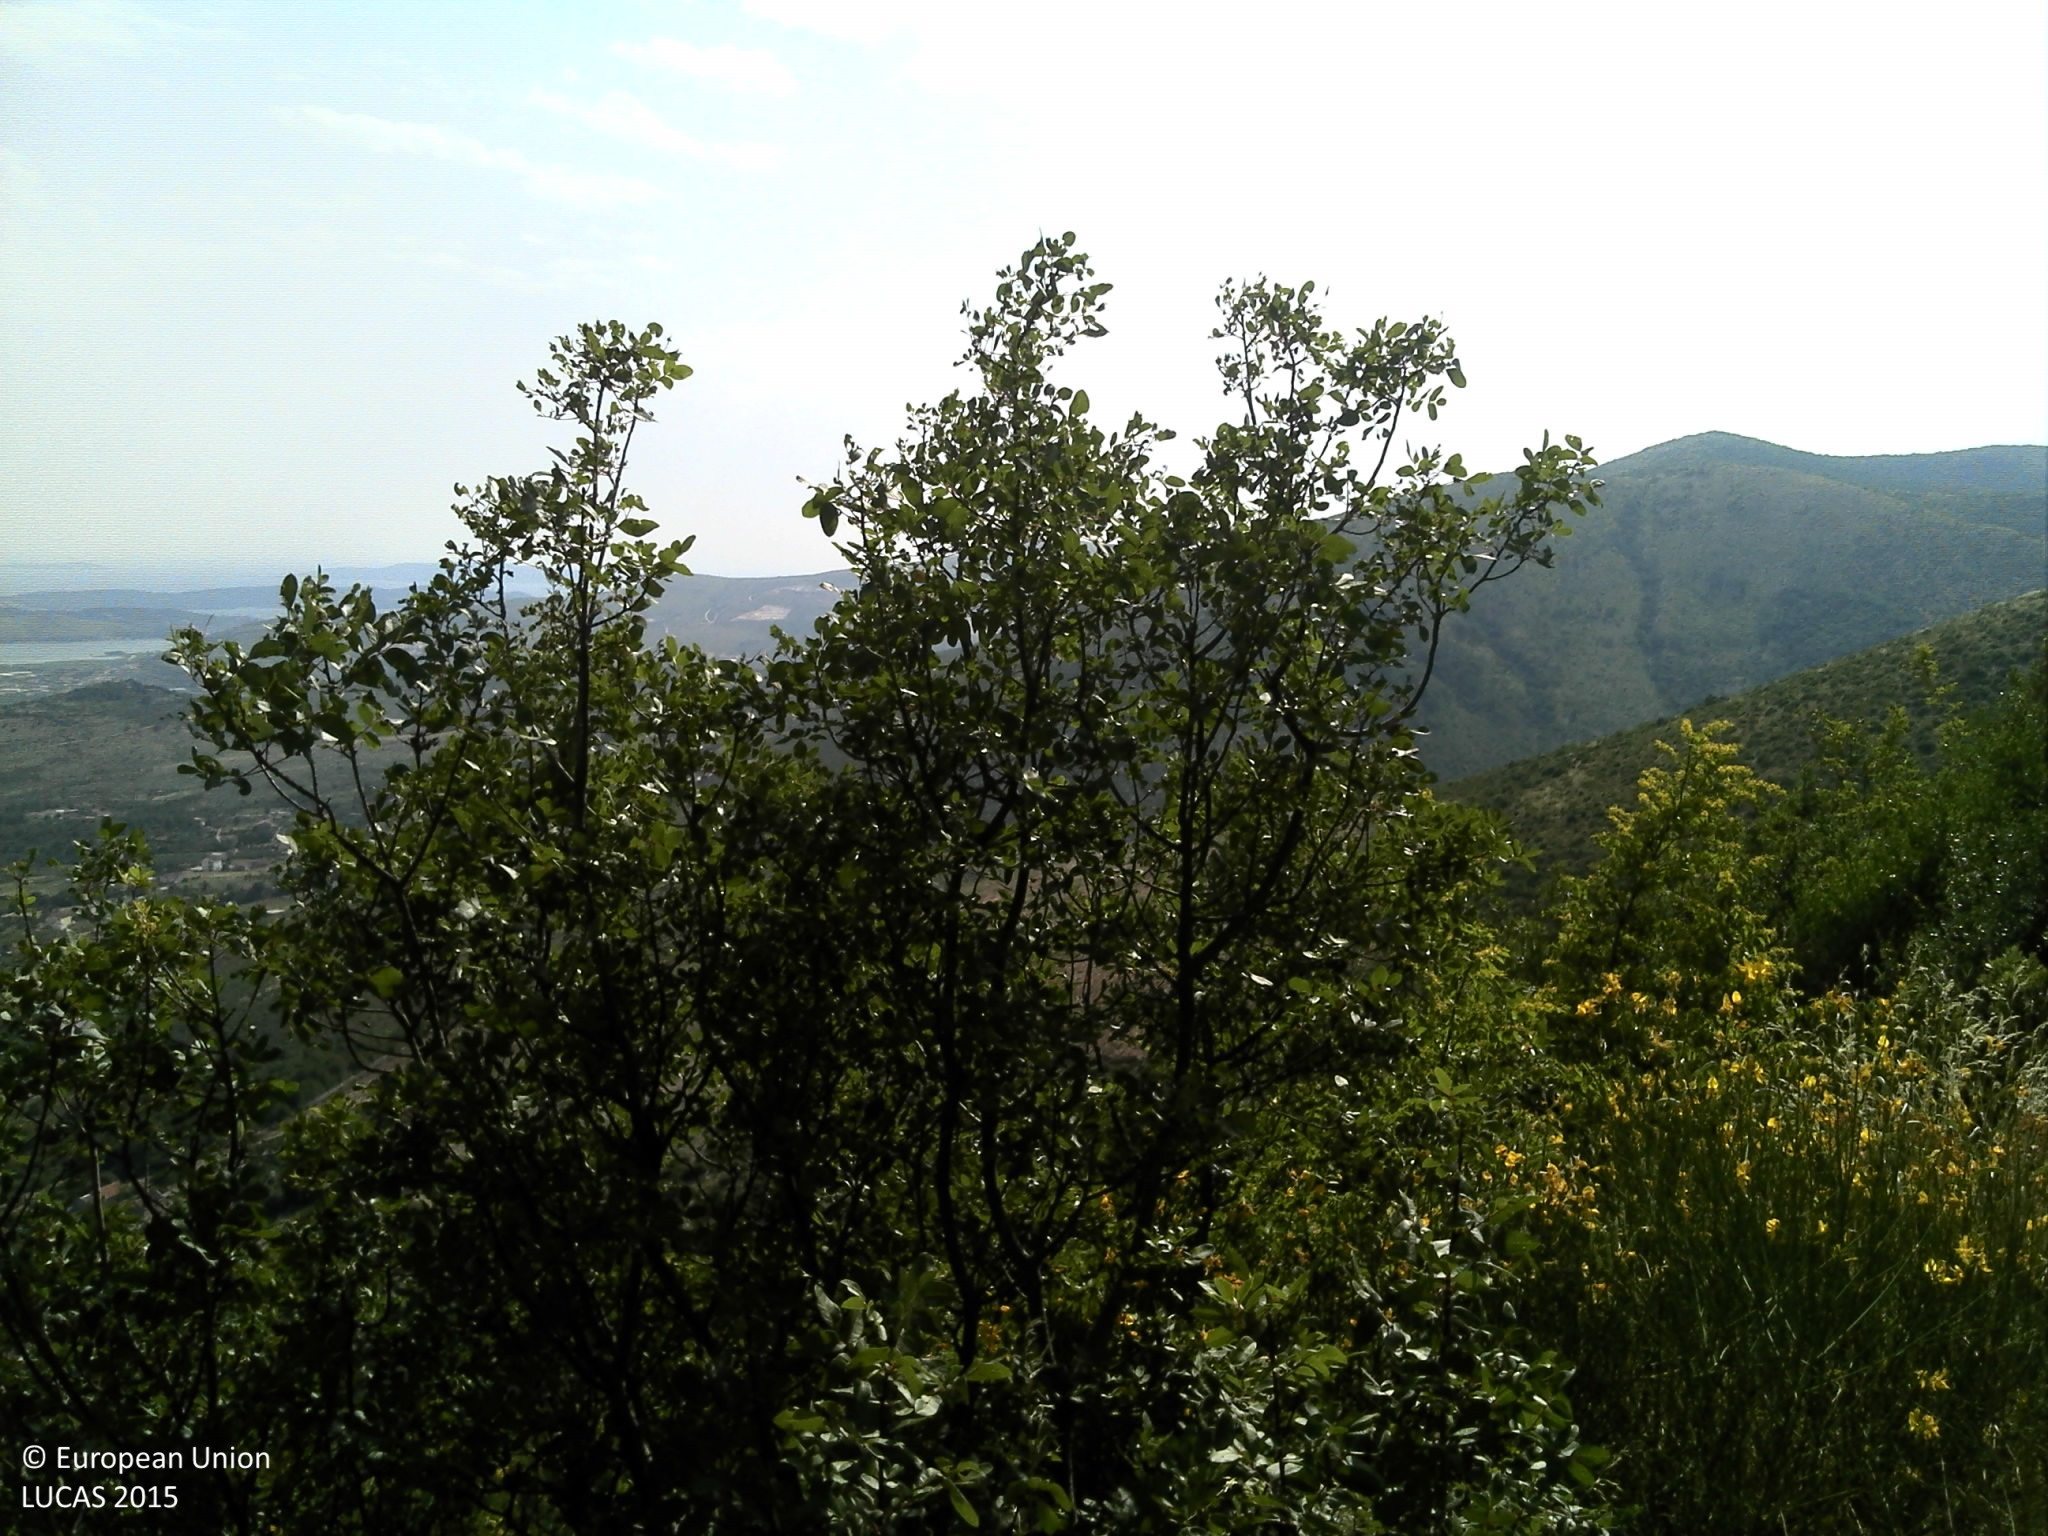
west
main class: Shrubland
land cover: Shrubland with sparse tree cover
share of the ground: > 75 %
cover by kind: shrubs 75 %, herbaceous plants 10 %, broadleaved forest trees 5 %, consolidated bare surface 5 %, unconsolidated bare surface 5 %
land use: Semi-natural and natural areas not in use
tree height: < 5 m
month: June
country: HR
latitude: 43.5790
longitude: 16.3189
